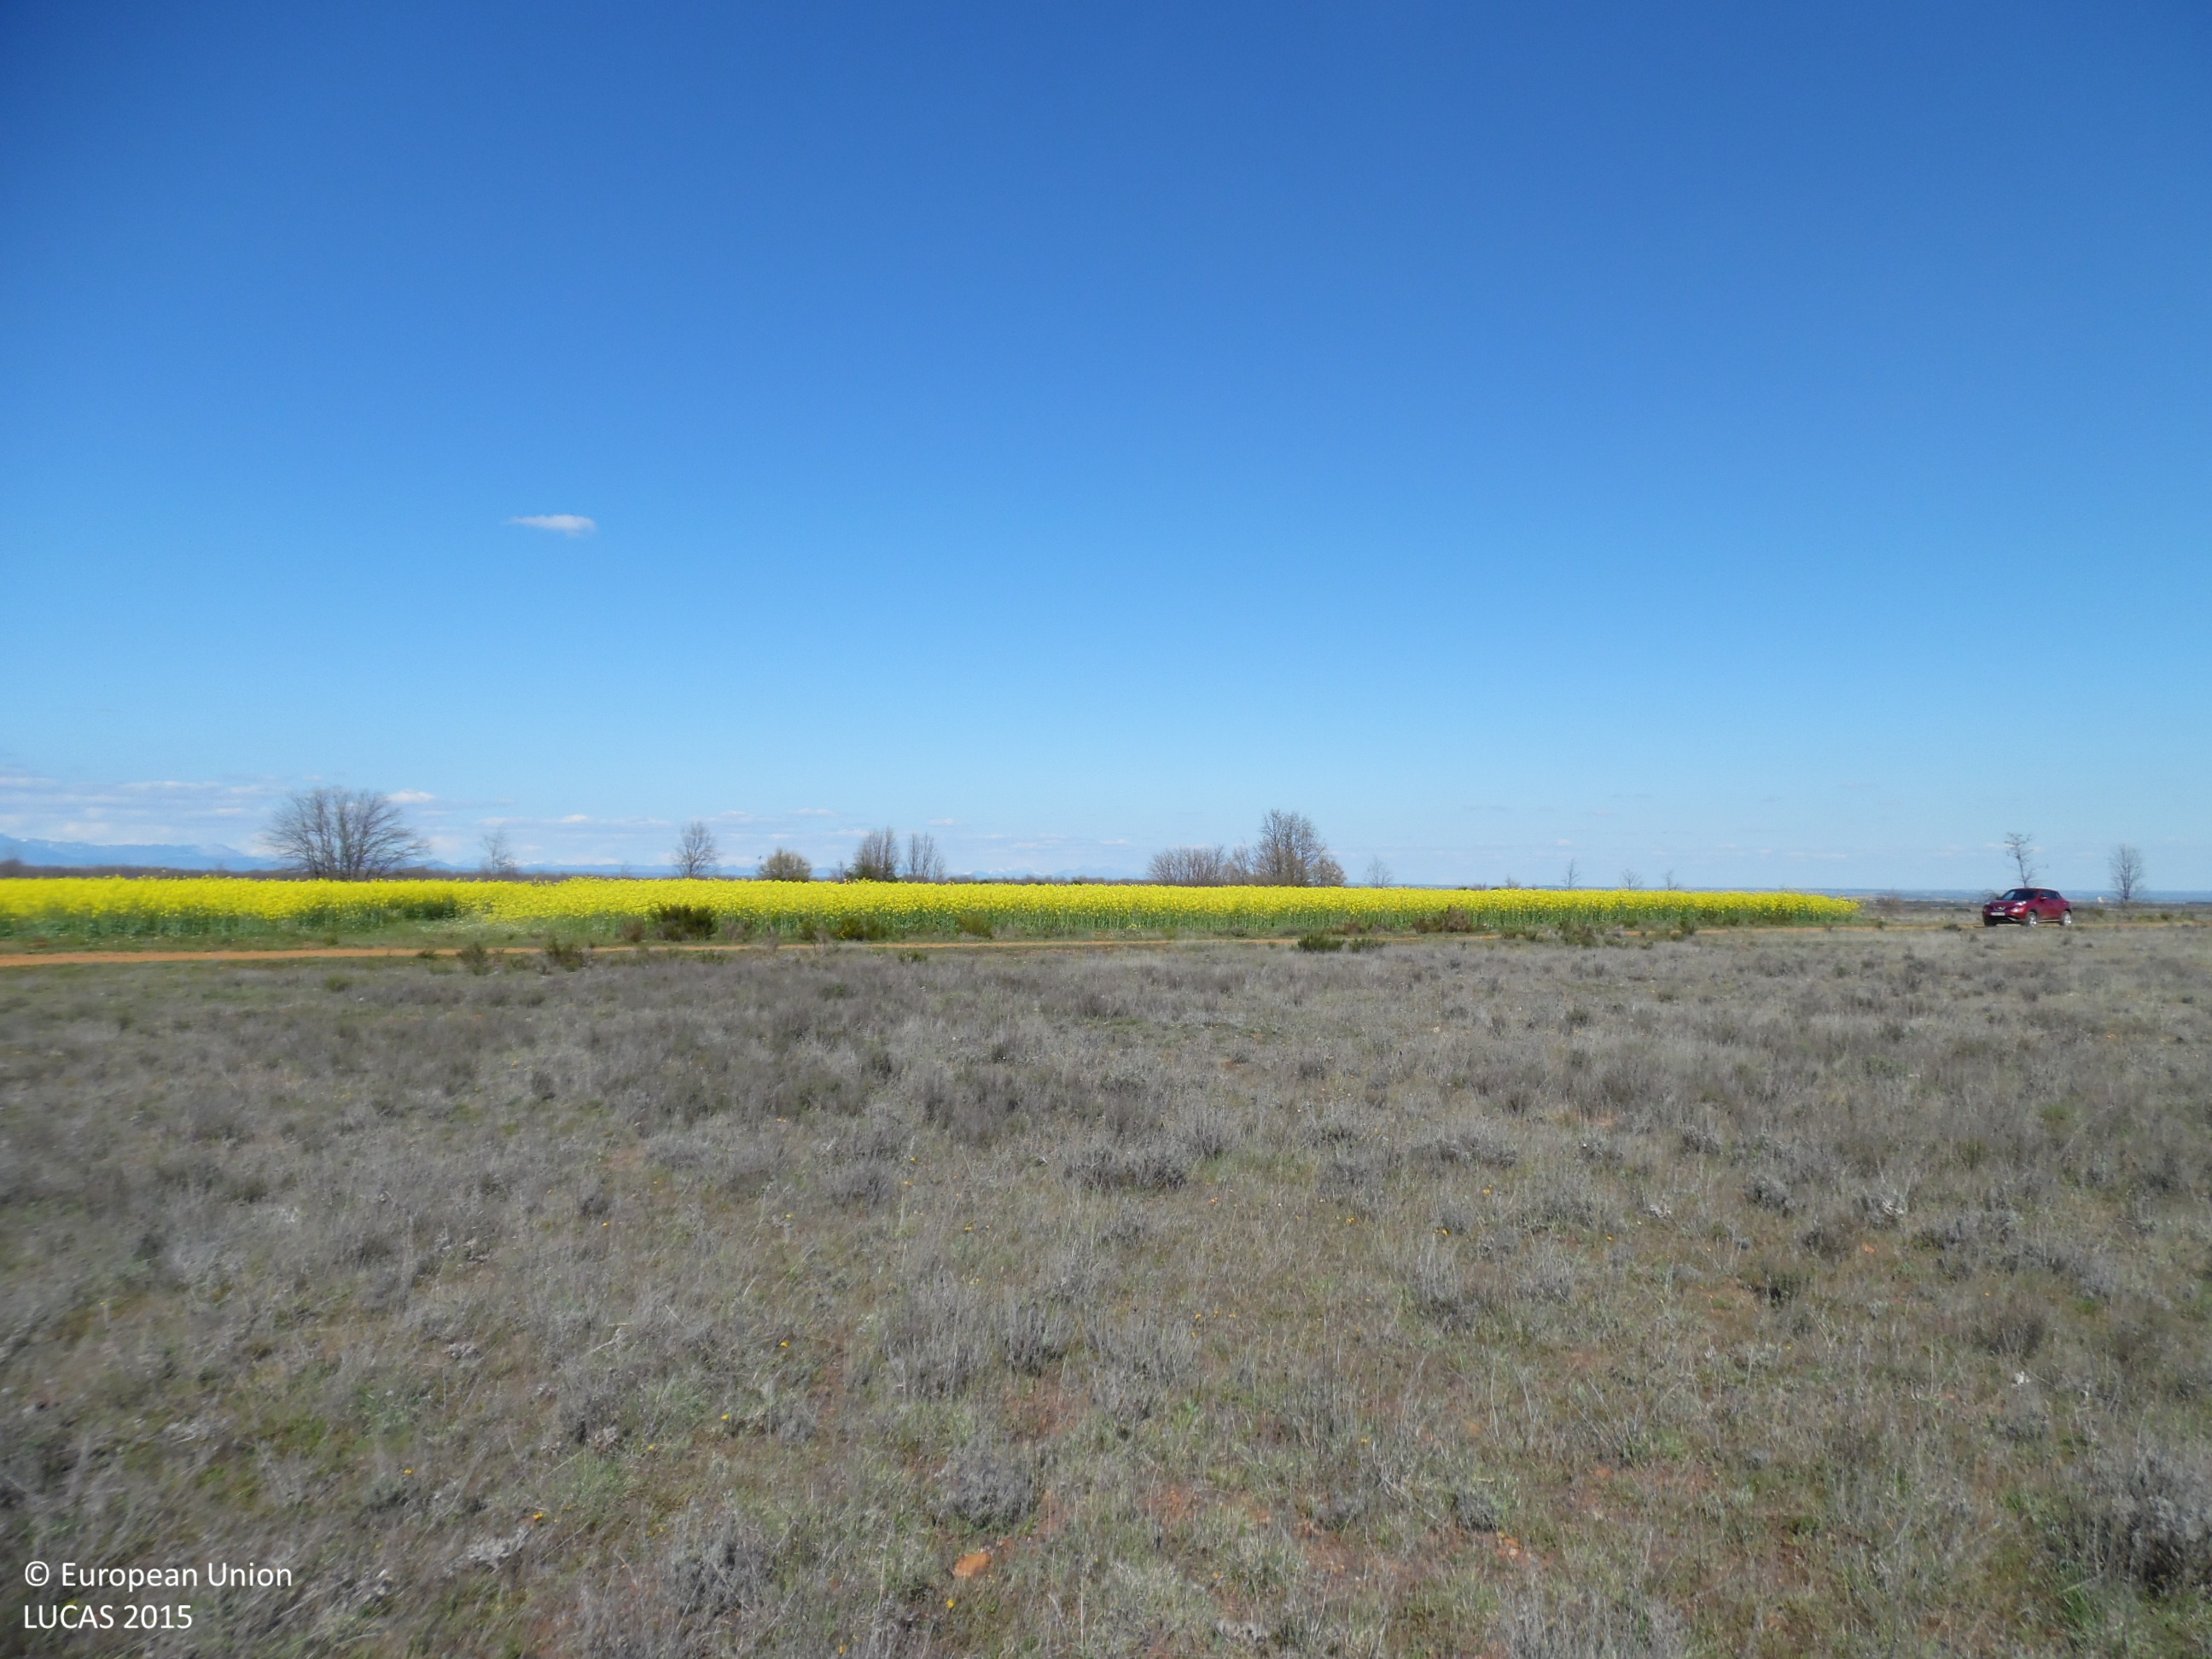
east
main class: Shrubland
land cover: Shrubland without tree cover
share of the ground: 50 - 75 %
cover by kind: shrubs 60 %, herbaceous plants 40 %
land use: Abandoned areas
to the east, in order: Shrubland without tree cover; Grass margins; Tracks; Grass margins; Grassland with sparse tree/shrub cover; Vineyards
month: April
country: ES
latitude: 42.5236
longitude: -5.6925
